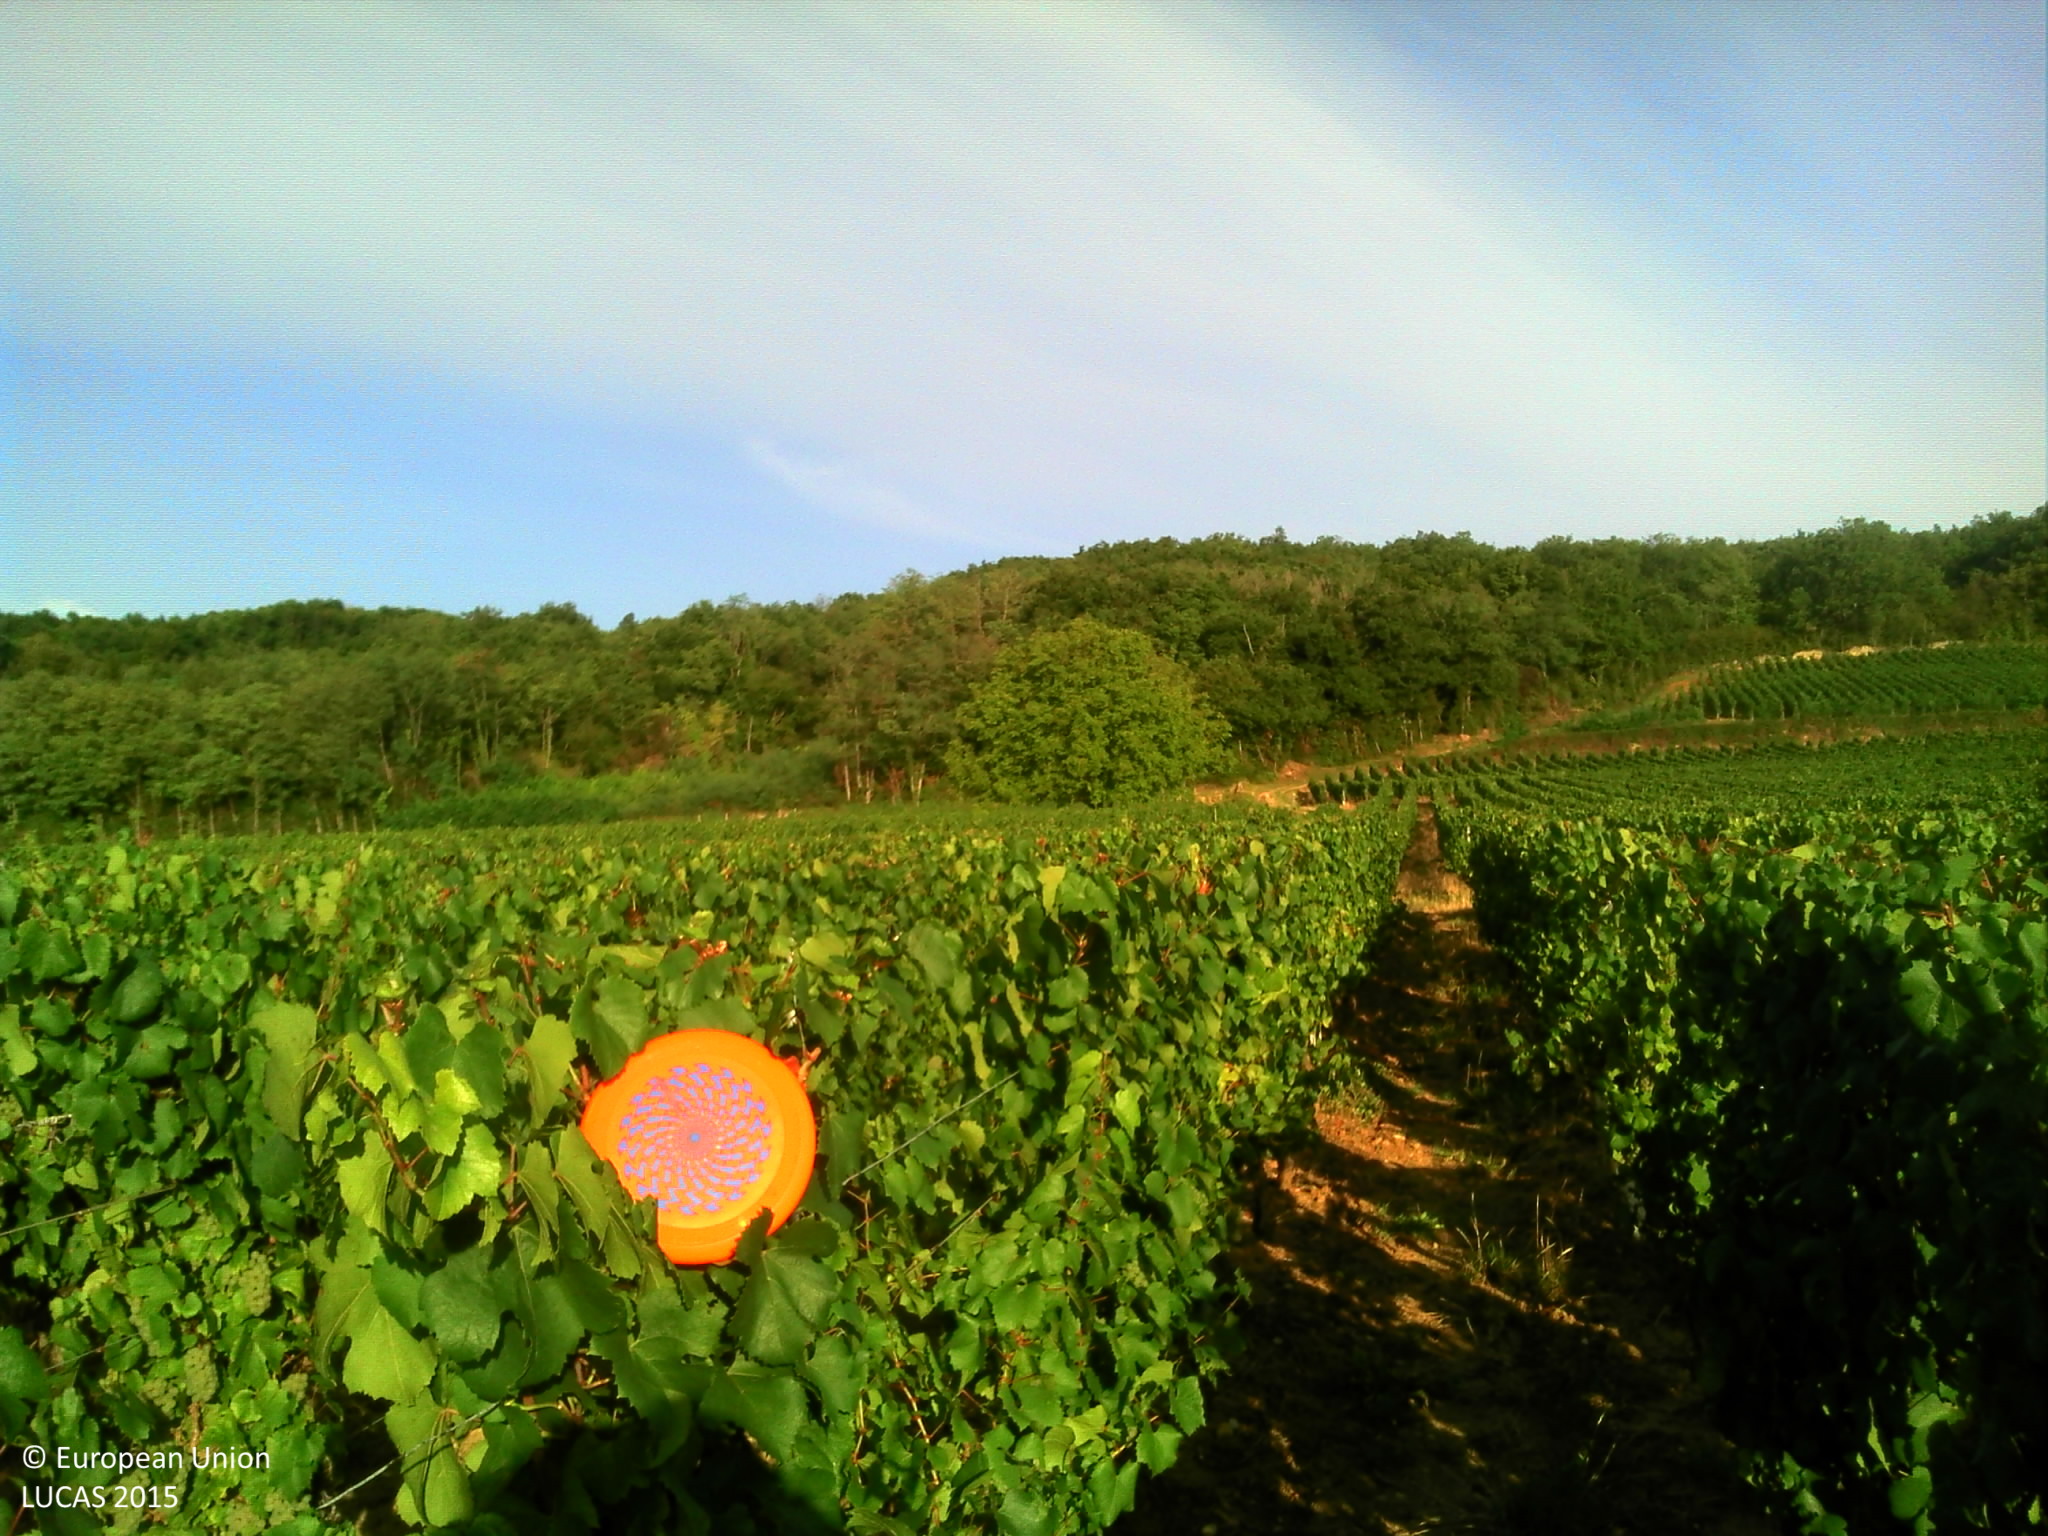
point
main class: Cropland
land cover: Vineyards
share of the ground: 50 - 75 %
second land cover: Other bare soil
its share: > 75 %
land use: Agriculture (excluding fallow land and kitchen gardens)
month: August
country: FR
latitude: 46.4430
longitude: 4.8344
